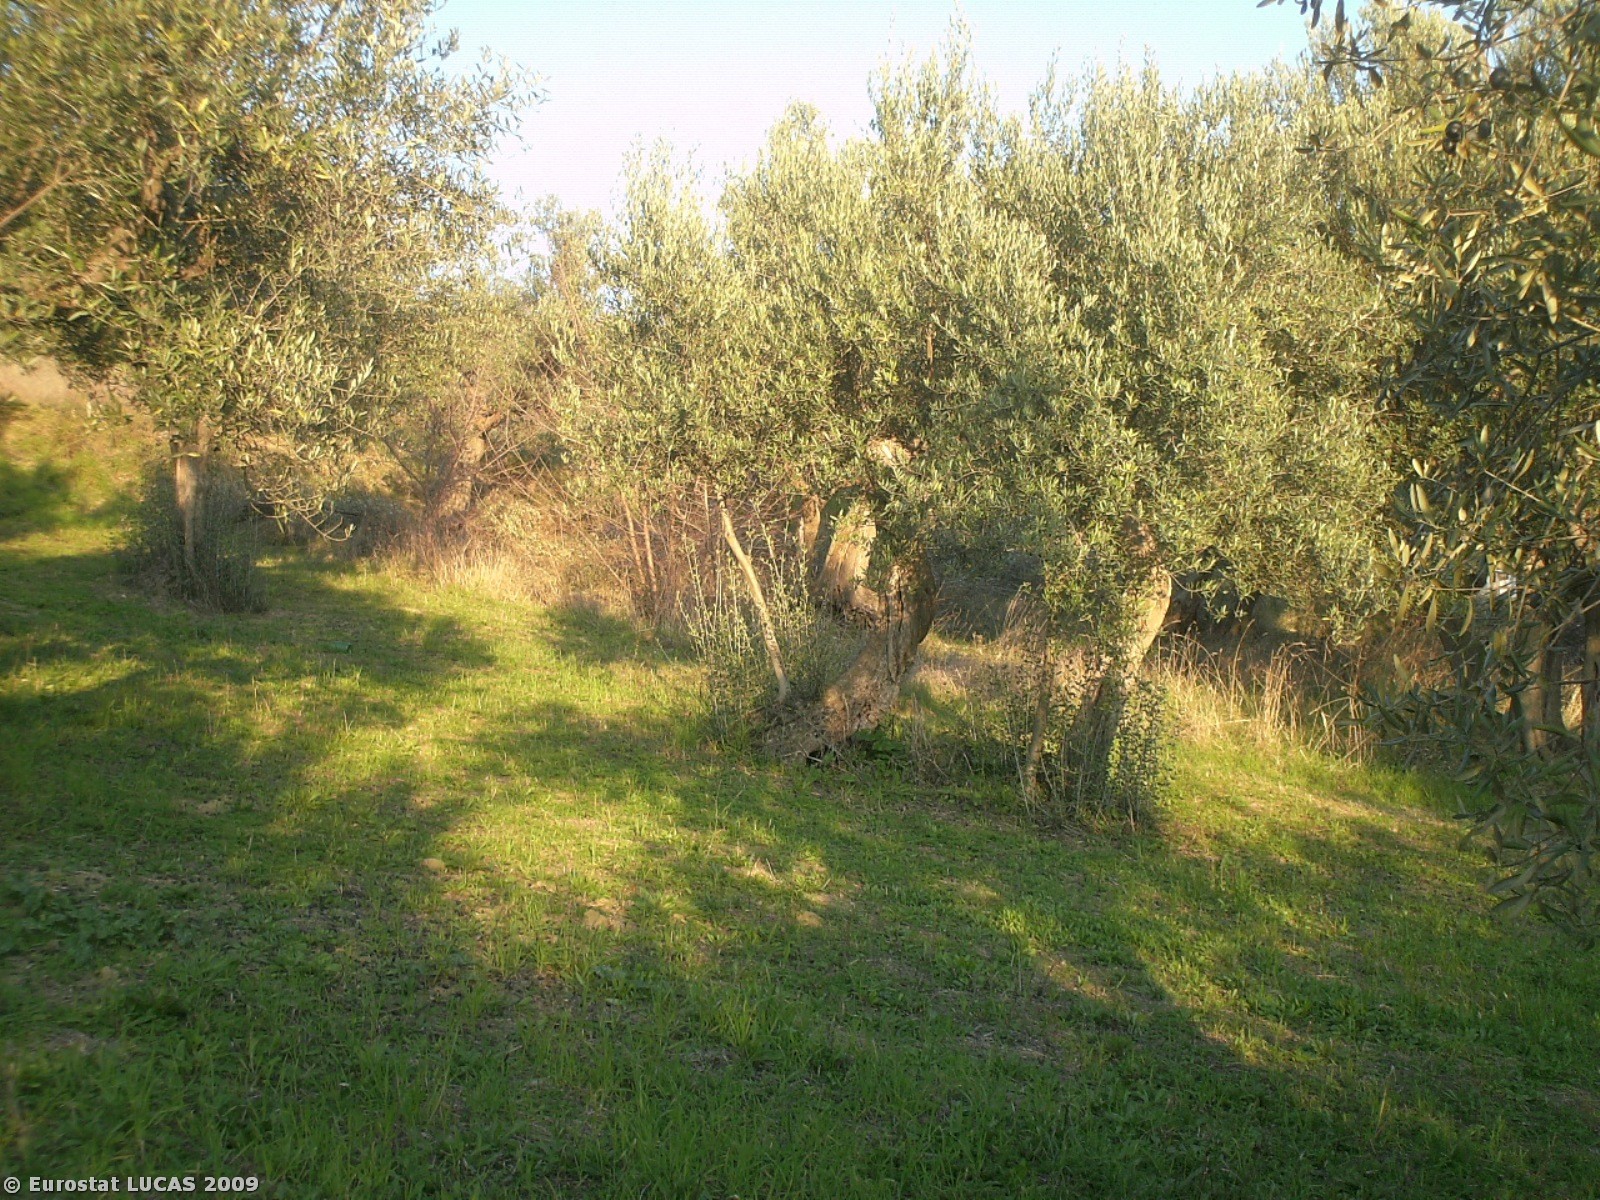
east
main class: Cropland
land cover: Olive groves
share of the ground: 50 - 75 %
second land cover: Grassland with sparse tree/shrub cover
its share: > 75 %
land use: Agriculture (excluding fallow land and kitchen gardens)
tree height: > 5 m
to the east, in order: Olive groves; Grassland with sparse tree/shrub cover; Paved roads, cycling and walking lanes; Olive groves; Grassland with sparse tree/shrub cover; Paved roads, cycling and walking lanes; Olive groves; Grassland with sparse tree/shrub cover; Tracks; Olive groves; Temporary grasslands
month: July
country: IT
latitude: 42.1964
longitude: 14.4066
